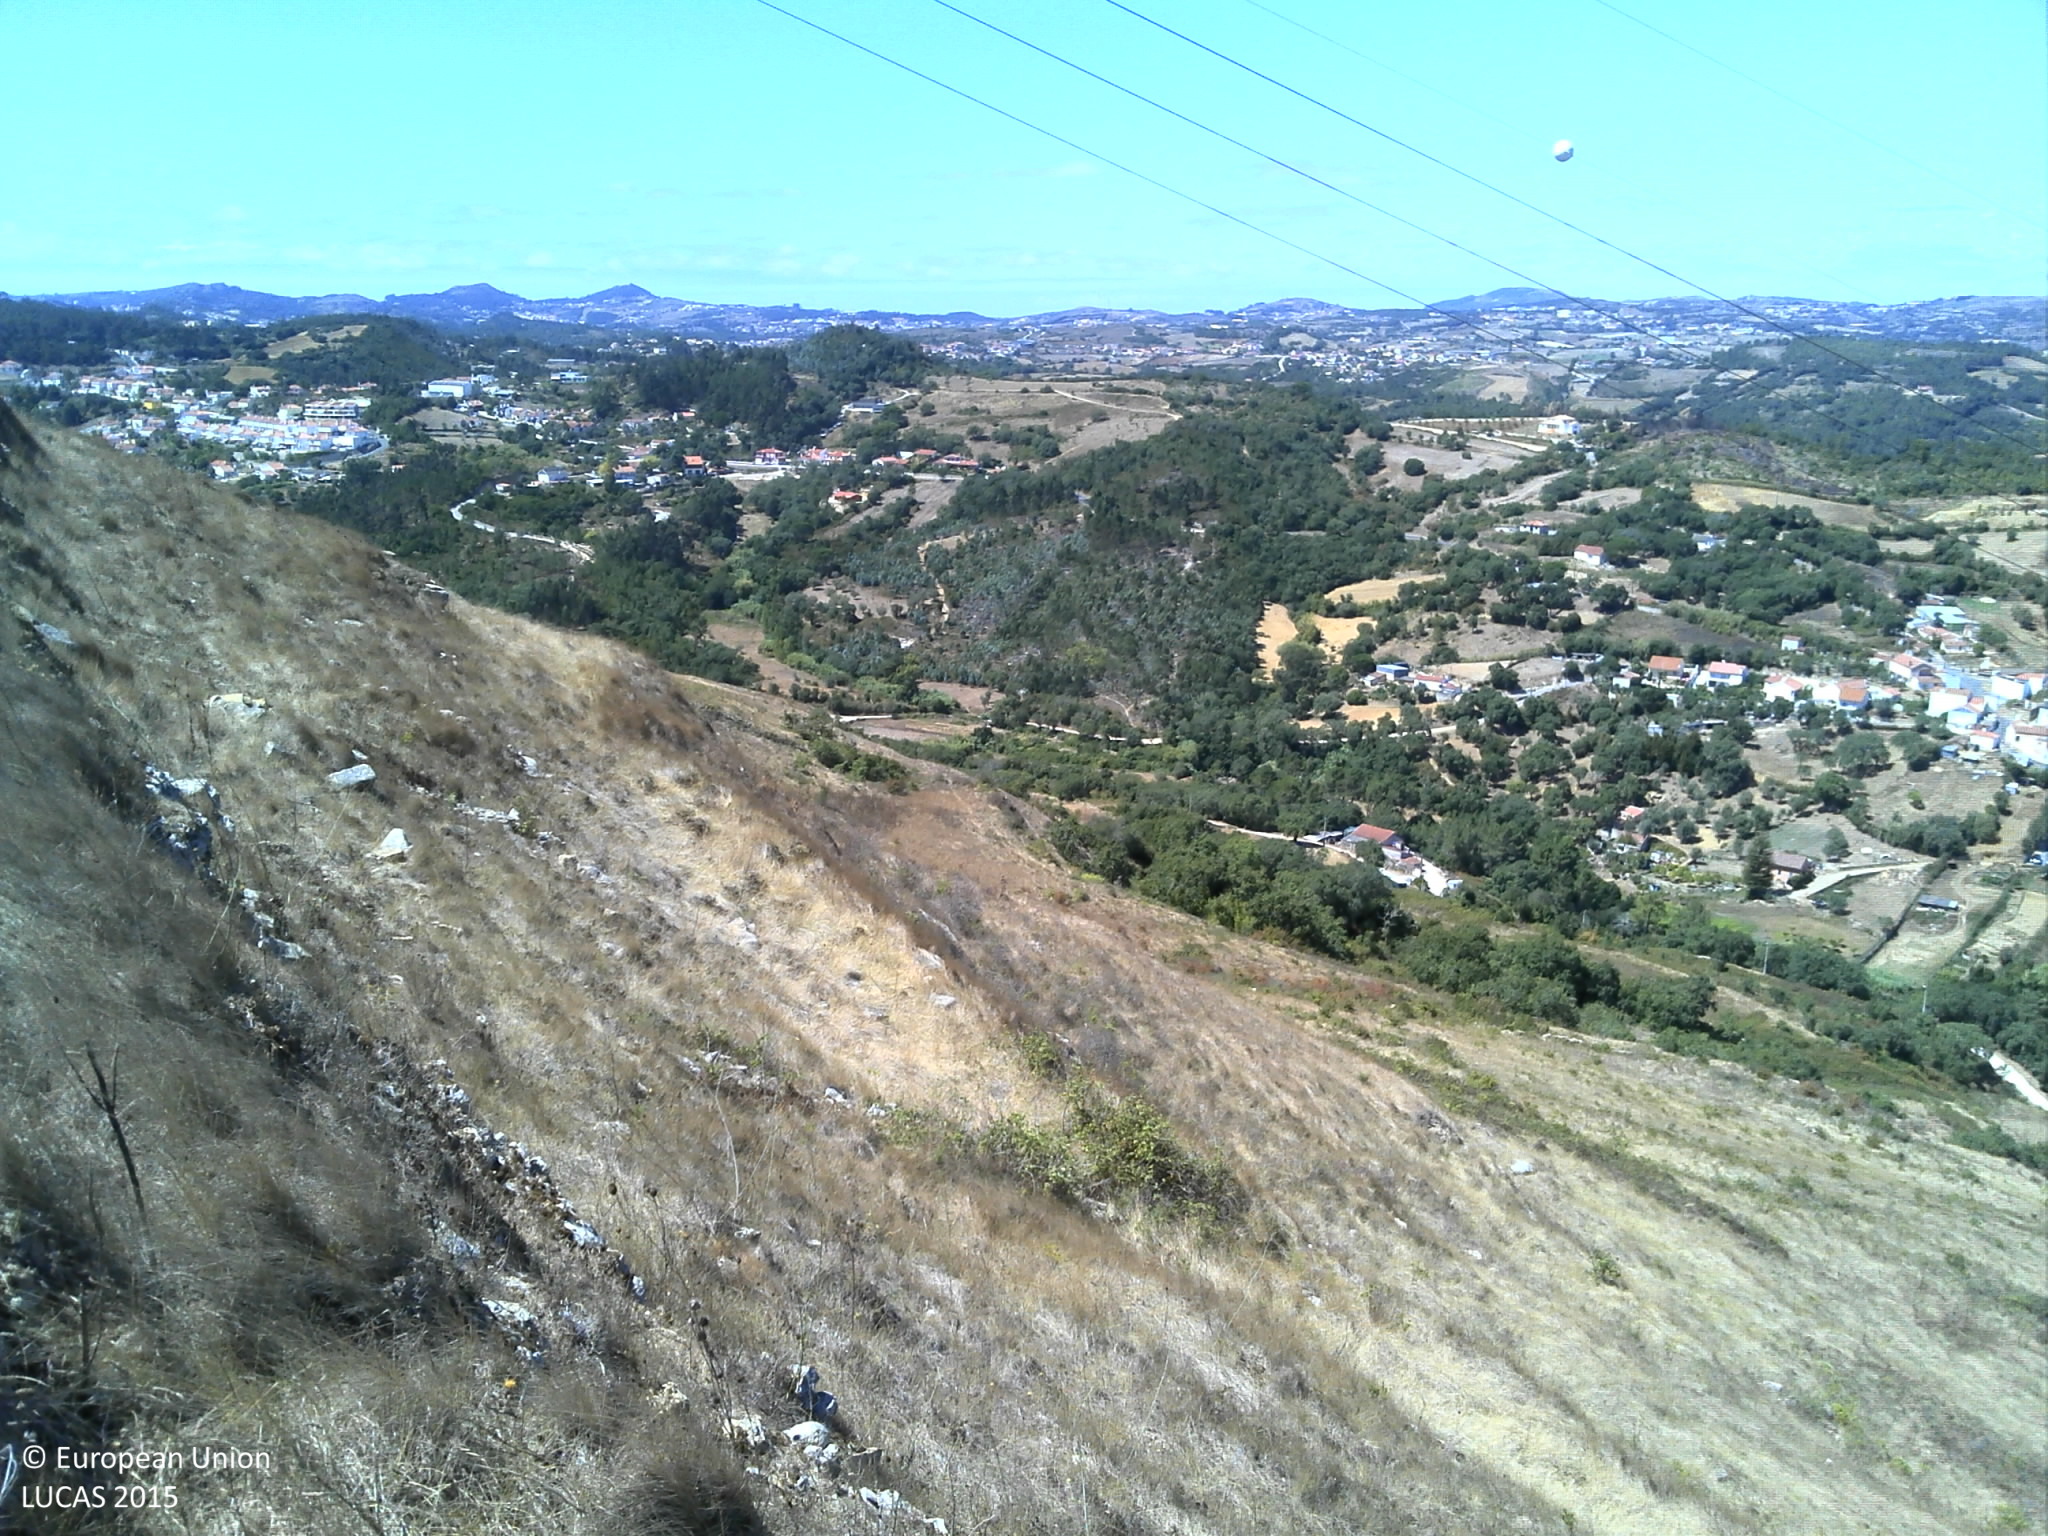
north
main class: Grassland
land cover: Grassland without tree/shrub cover
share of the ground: 50 - 75 %
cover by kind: herbaceous plants 70 %, unconsolidated bare surface 30 %
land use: Semi-natural and natural areas not in use
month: August
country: PT
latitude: 38.8961
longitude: -9.1613
